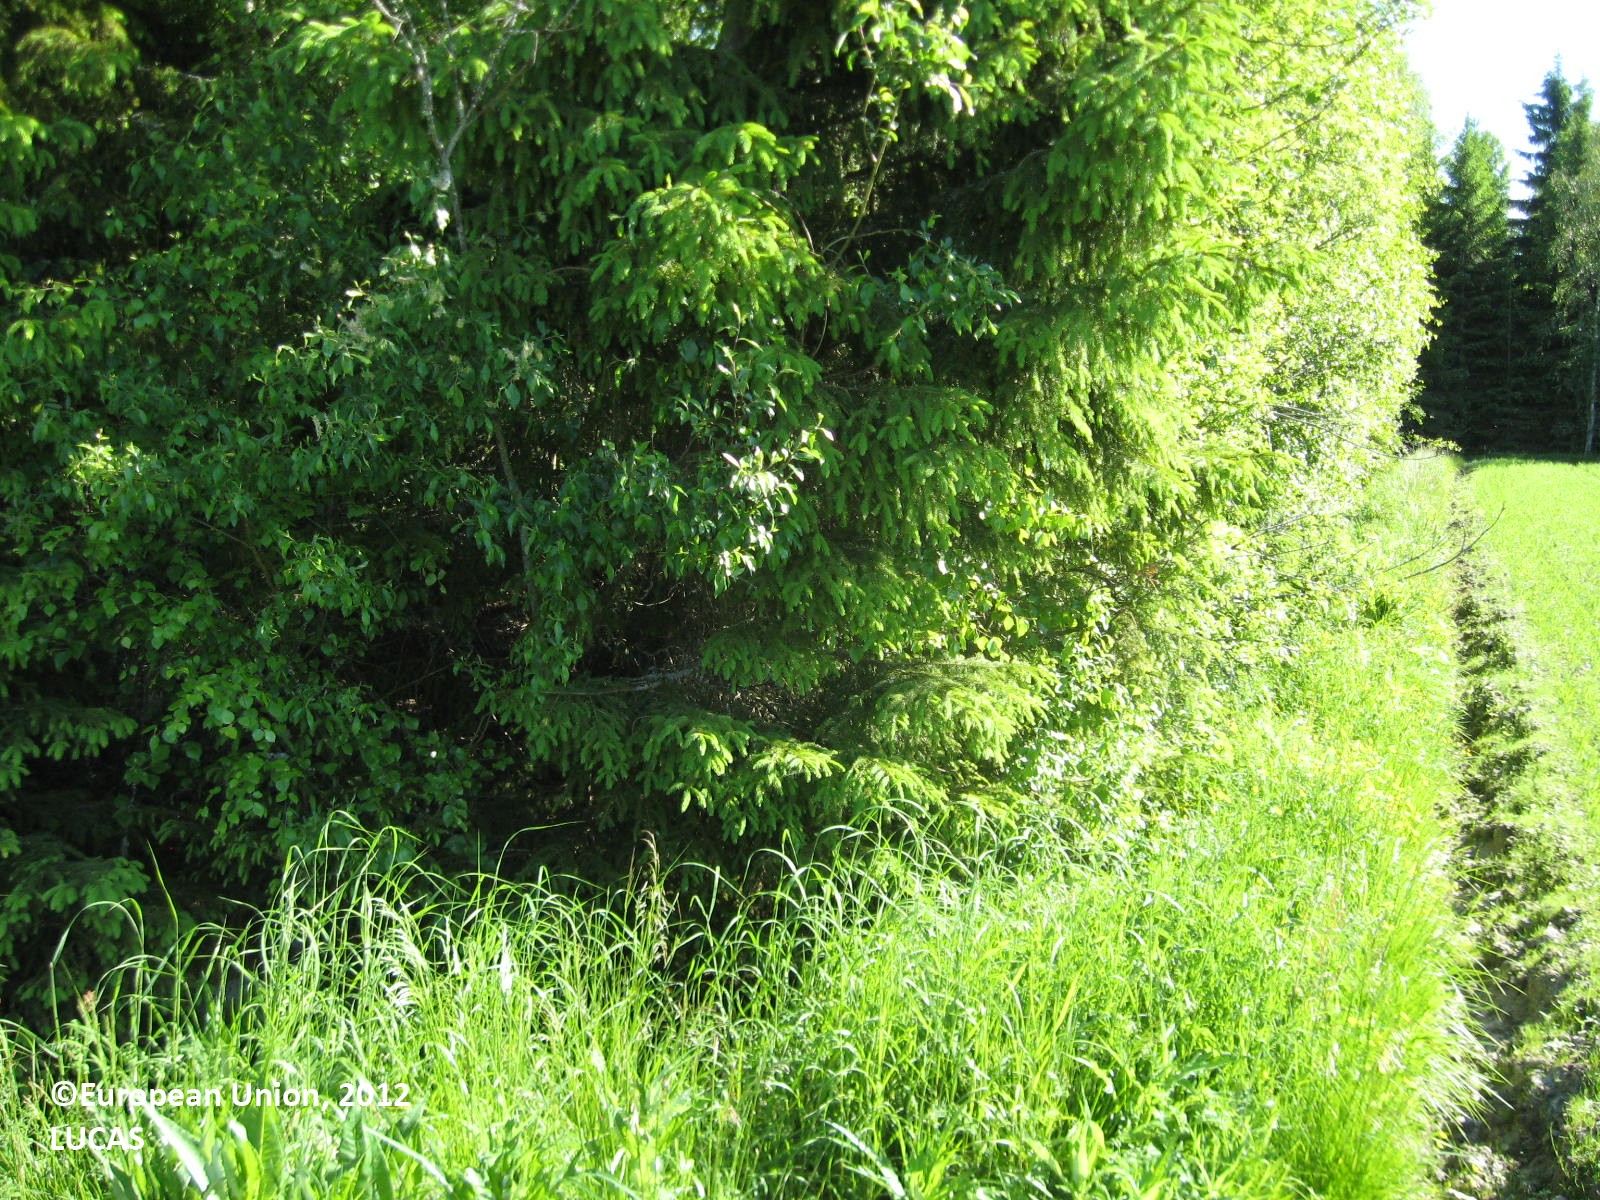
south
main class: Cropland
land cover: Rye
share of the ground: > 75 %
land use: Agriculture (excluding fallow land and kitchen gardens)
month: June
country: FI
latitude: 62.7431
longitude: 21.6493
